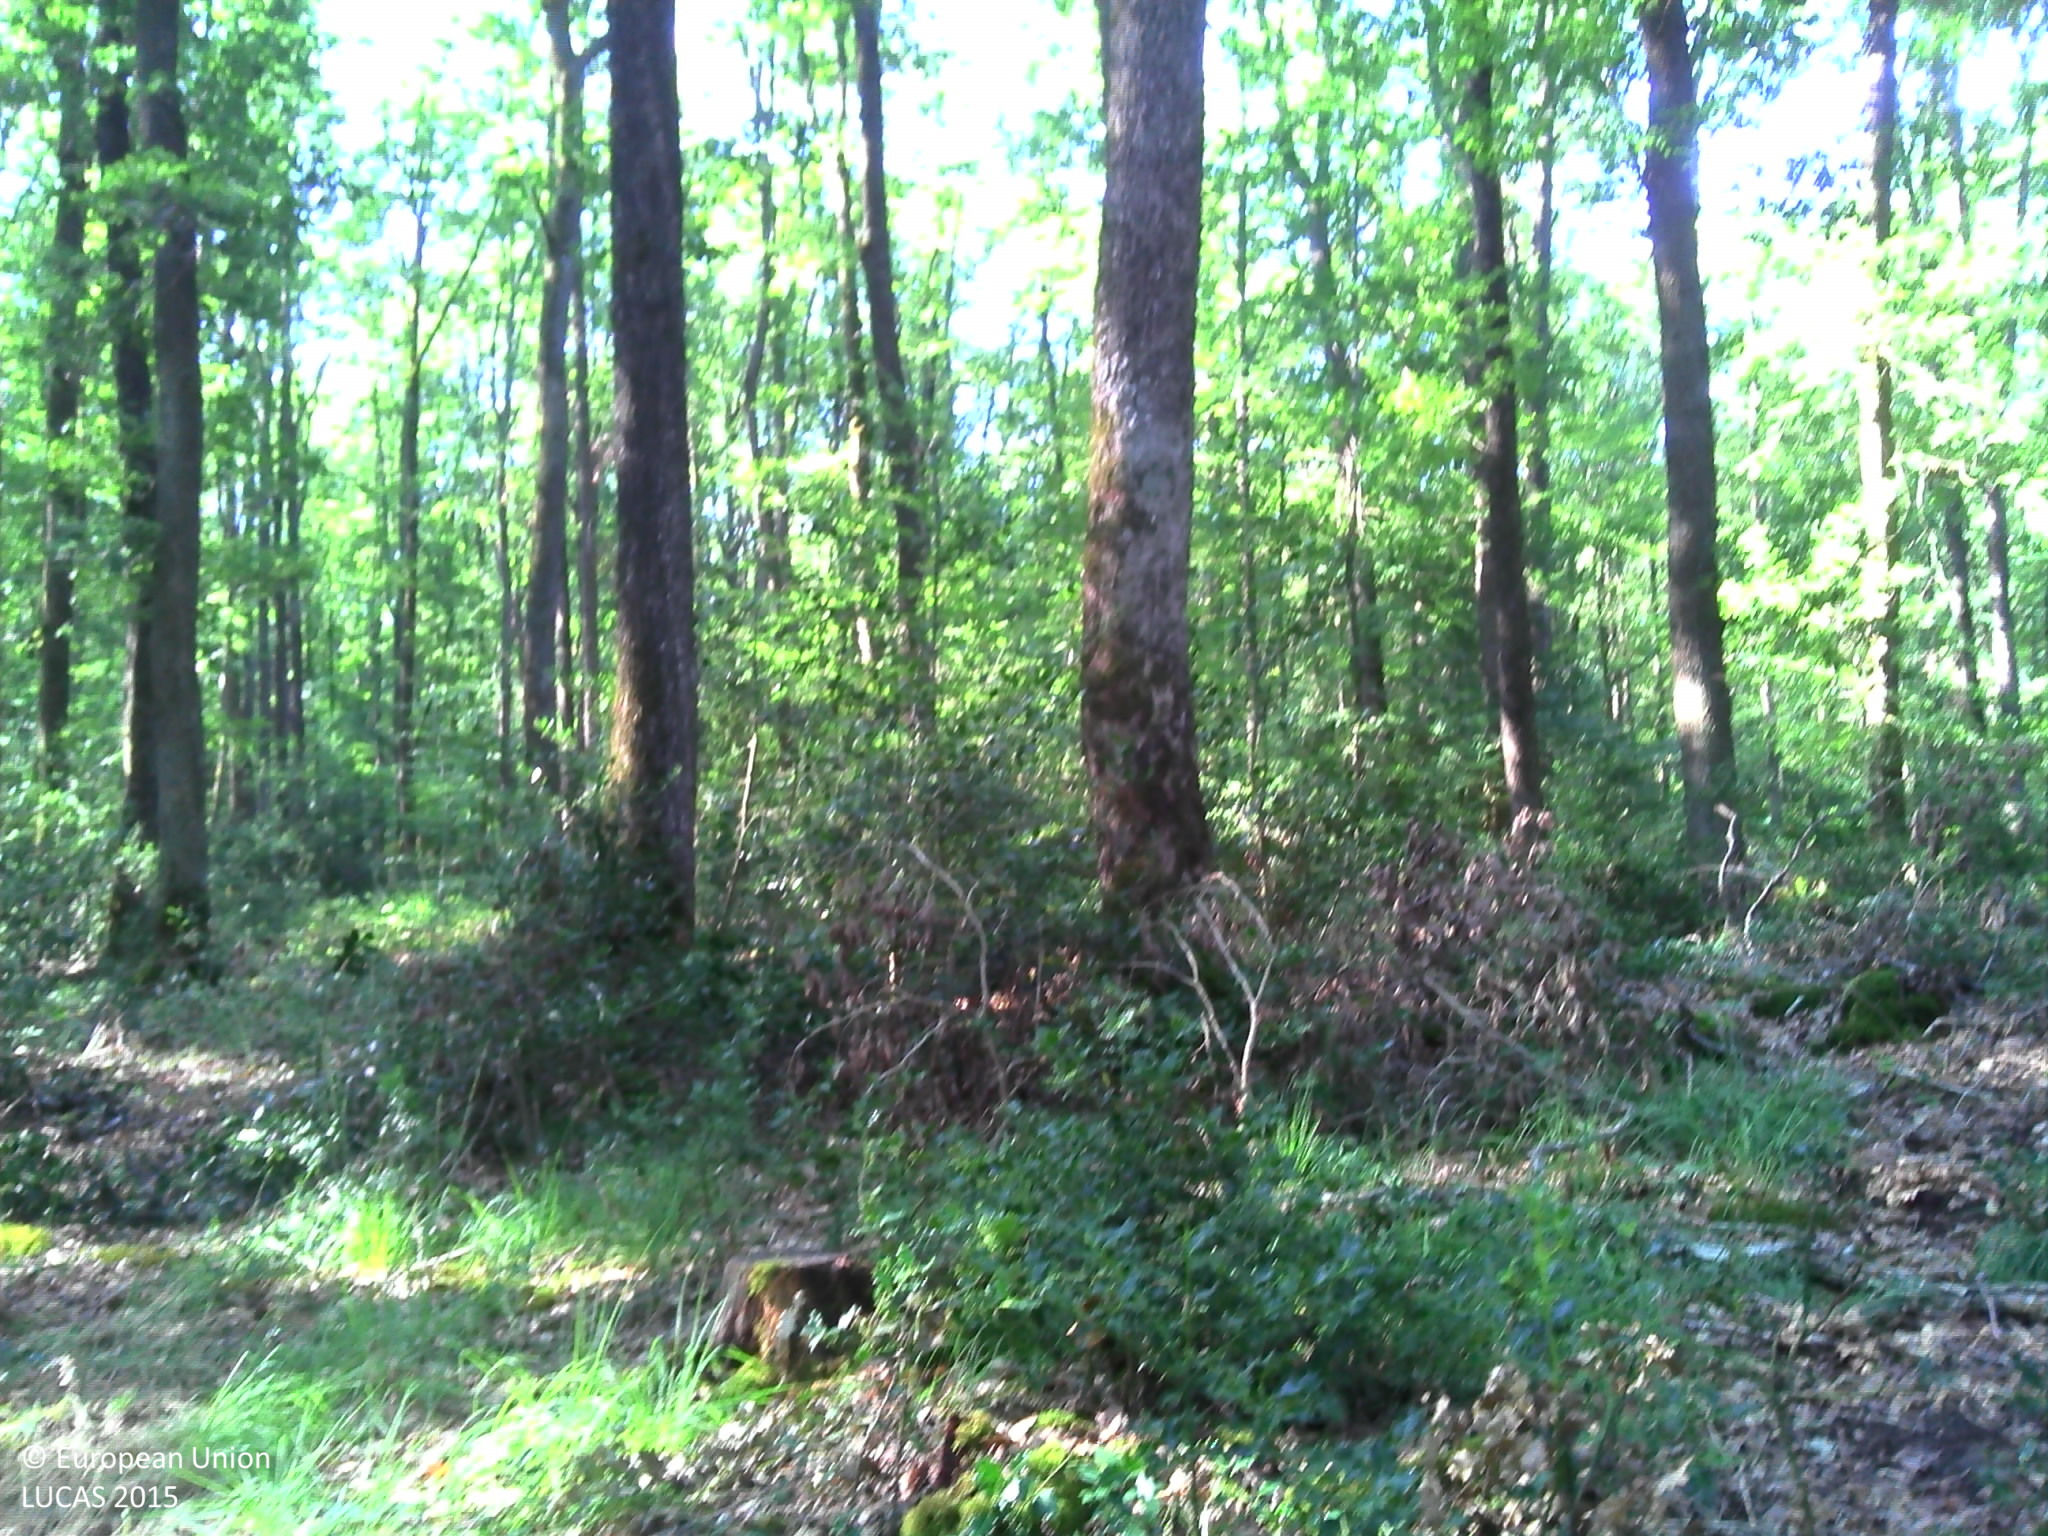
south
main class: Woodland
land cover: Broadleaved woodland
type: mesophytic deciduous forest
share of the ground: > 75 %
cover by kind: broadleaved forest trees 90 %, shrubs 5 %, herbaceous plants 5 %
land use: Forestry
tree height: > 5 m
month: August
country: FR
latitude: 46.6523
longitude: 2.8223
